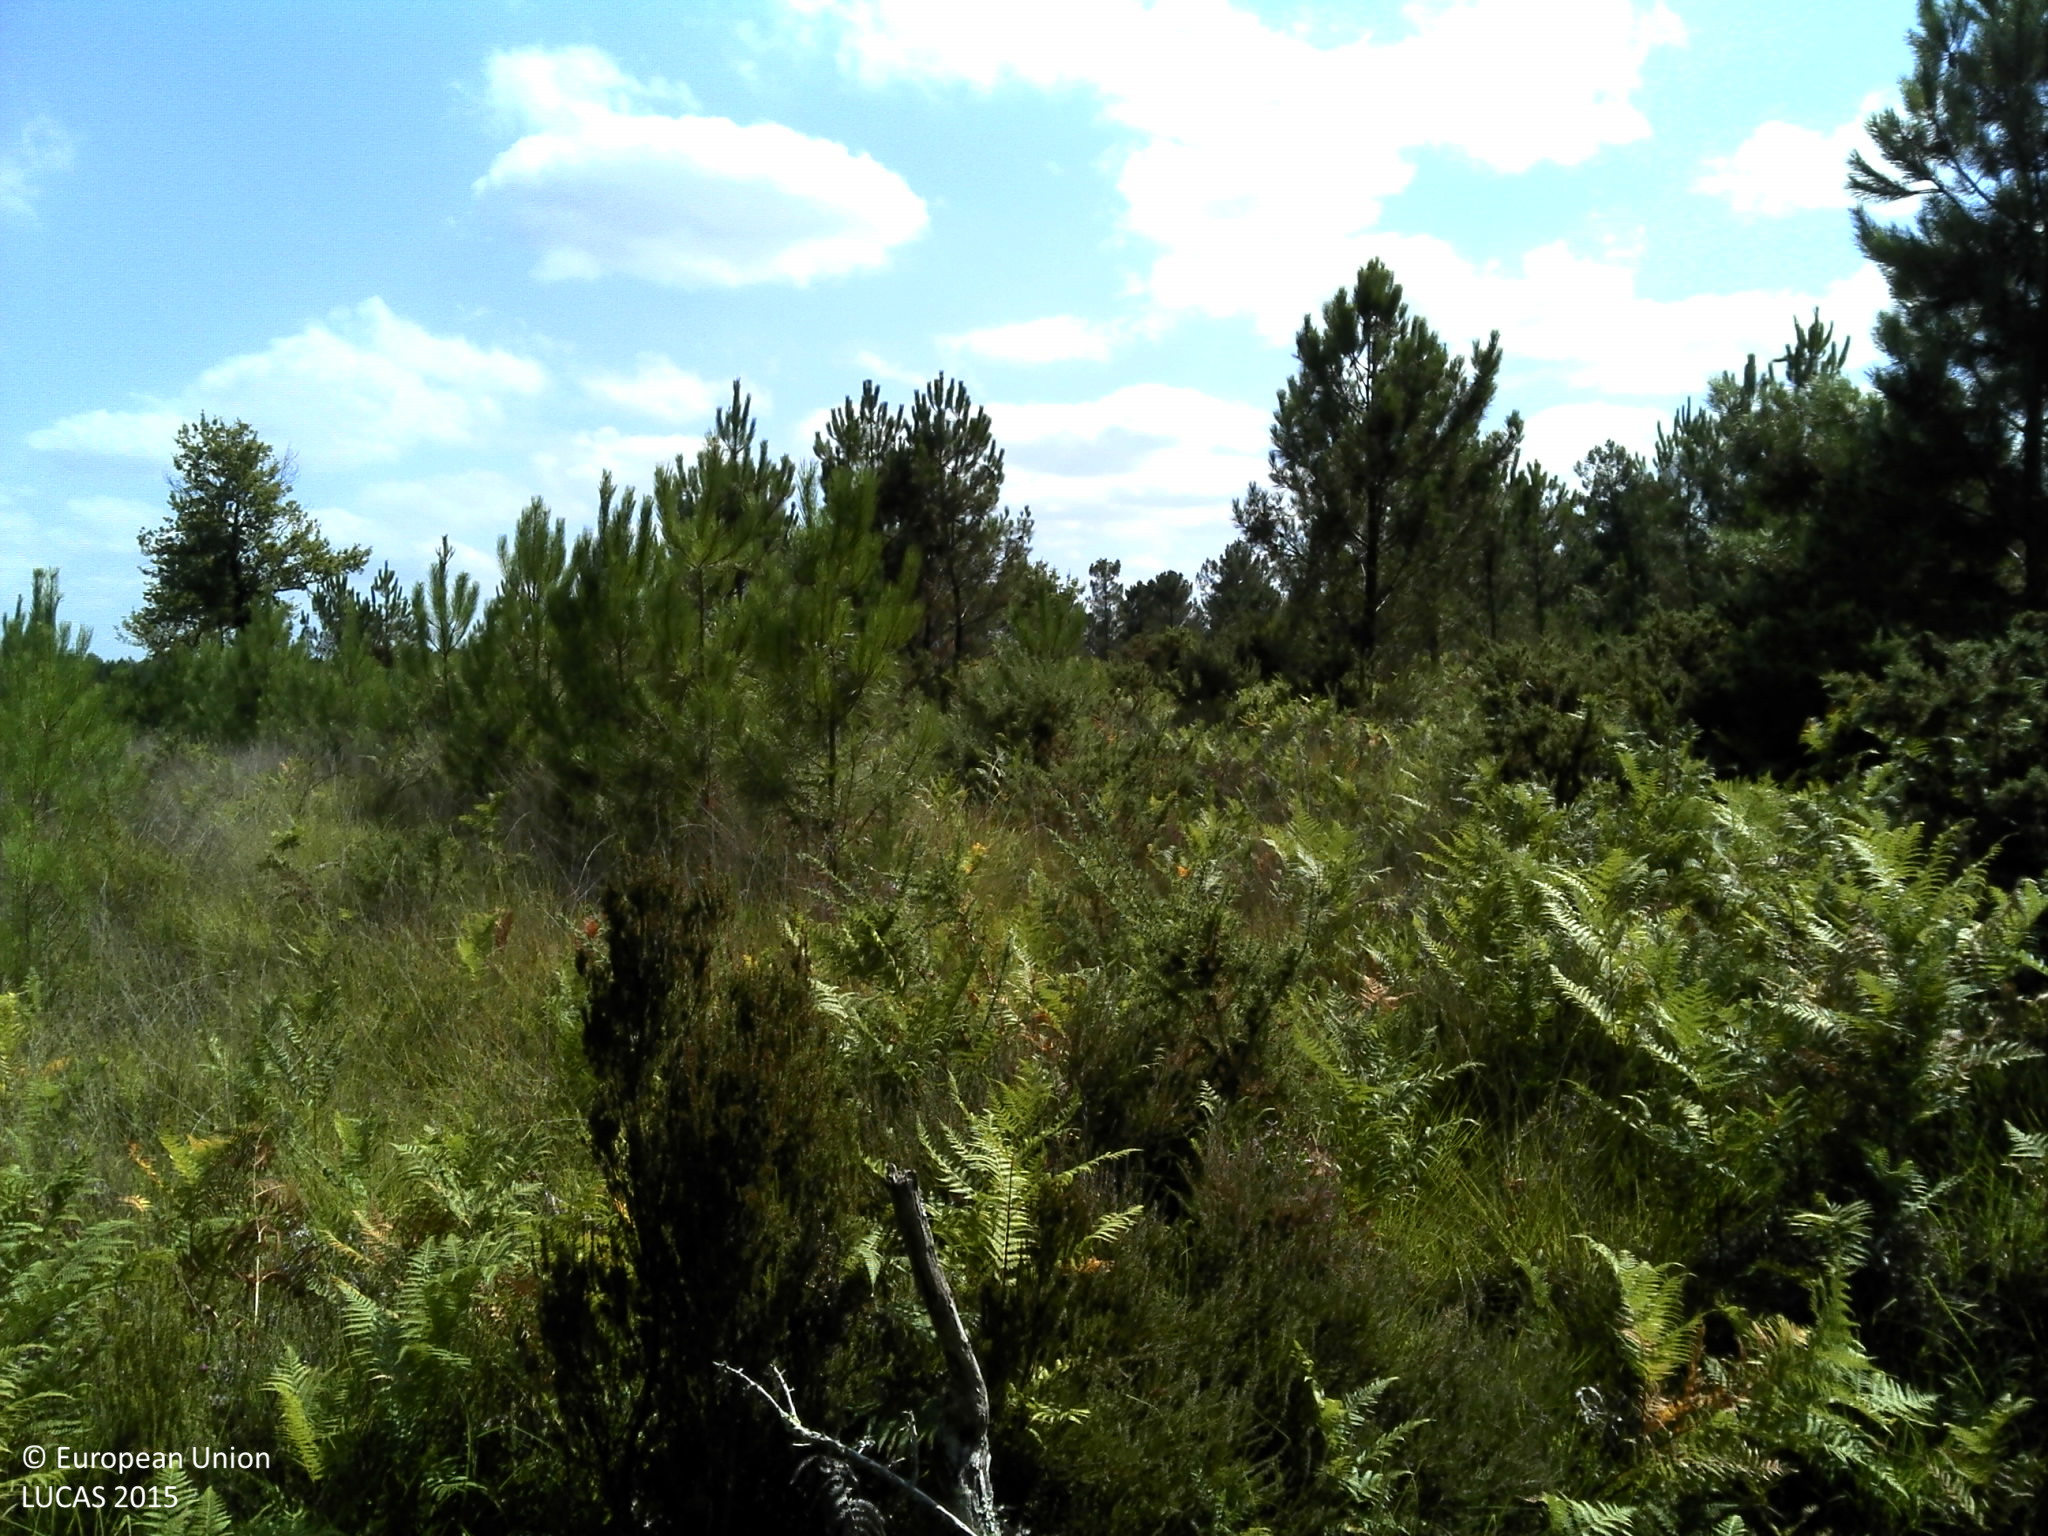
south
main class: Shrubland
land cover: Shrubland with sparse tree cover
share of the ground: > 75 %
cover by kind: shrubs 75 %, herbaceous plants 20 %, coniferous forest trees 5 %
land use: Forestry
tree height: < 5 m
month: August
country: FR
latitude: 45.0905
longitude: -0.8352
